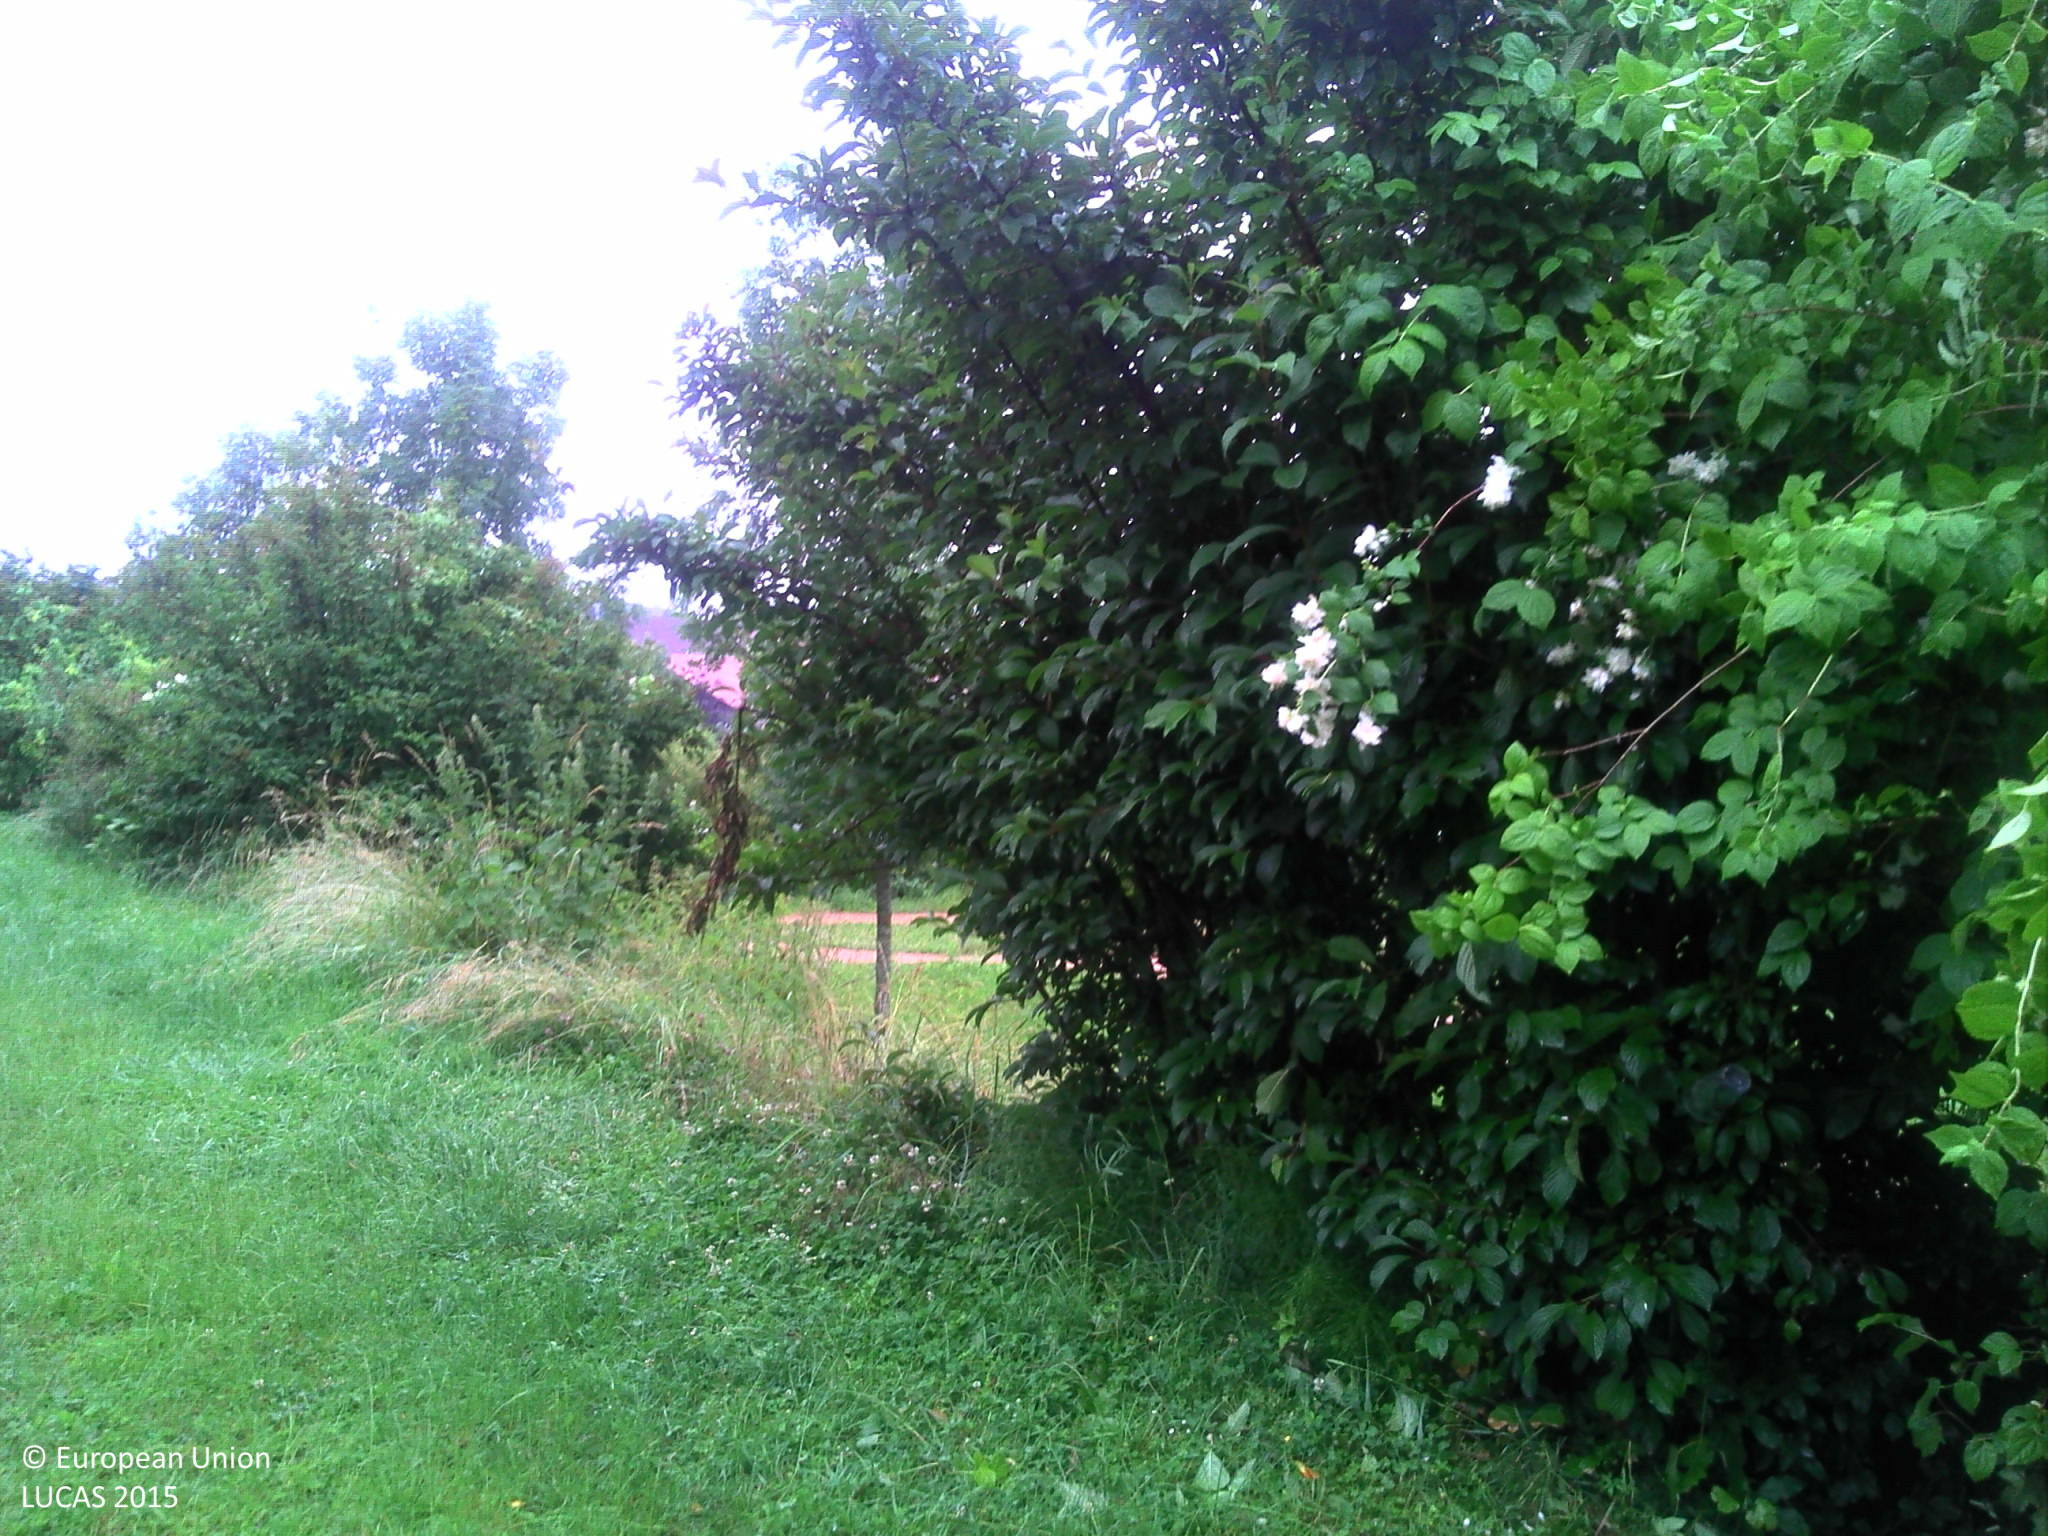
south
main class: Grassland
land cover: Grassland with sparse tree/shrub cover
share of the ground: > 75 %
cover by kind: herbaceous plants 95 %, broadleaved forest trees 5 %
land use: Agriculture (excluding fallow land and kitchen gardens)
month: June
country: FR
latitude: 47.6522
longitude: 7.3788
